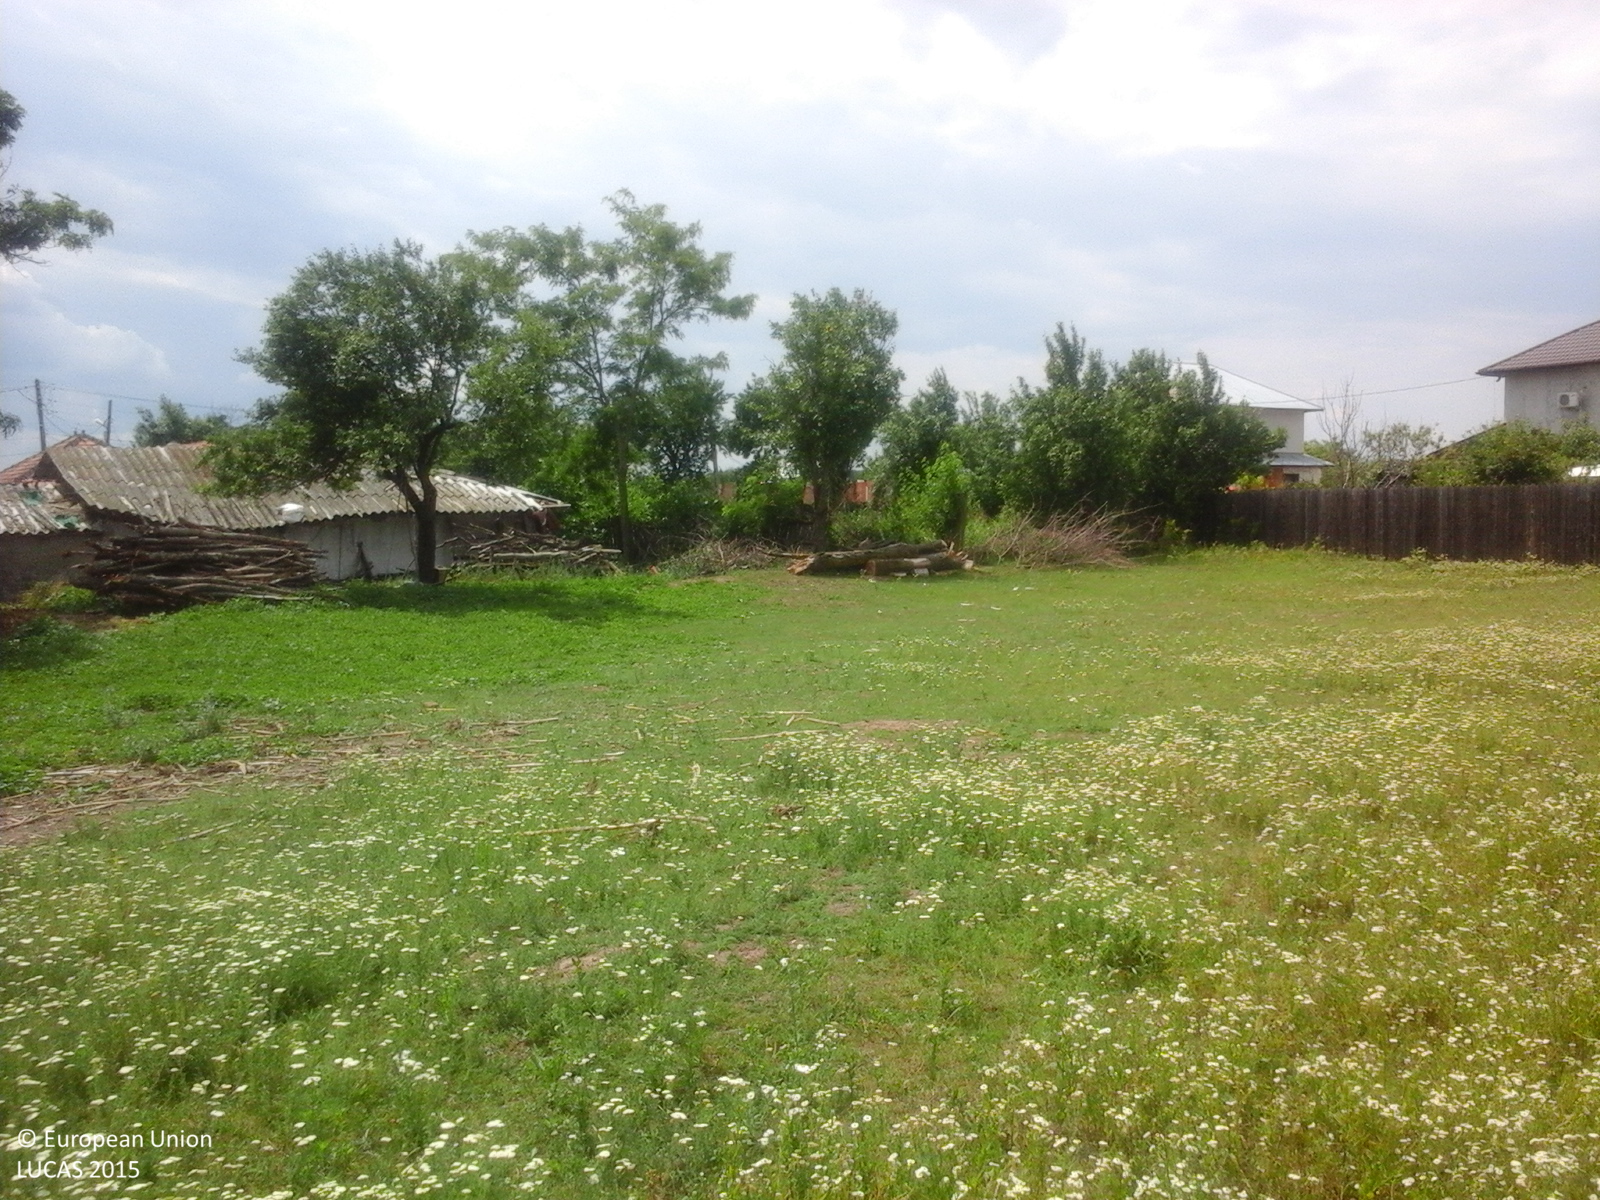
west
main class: Grassland
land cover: Grassland without tree/shrub cover
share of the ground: > 75 %
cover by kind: herbaceous plants 100 %
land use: Agriculture (excluding fallow land and kitchen gardens)
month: June
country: RO
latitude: 44.6198
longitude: 26.2549
